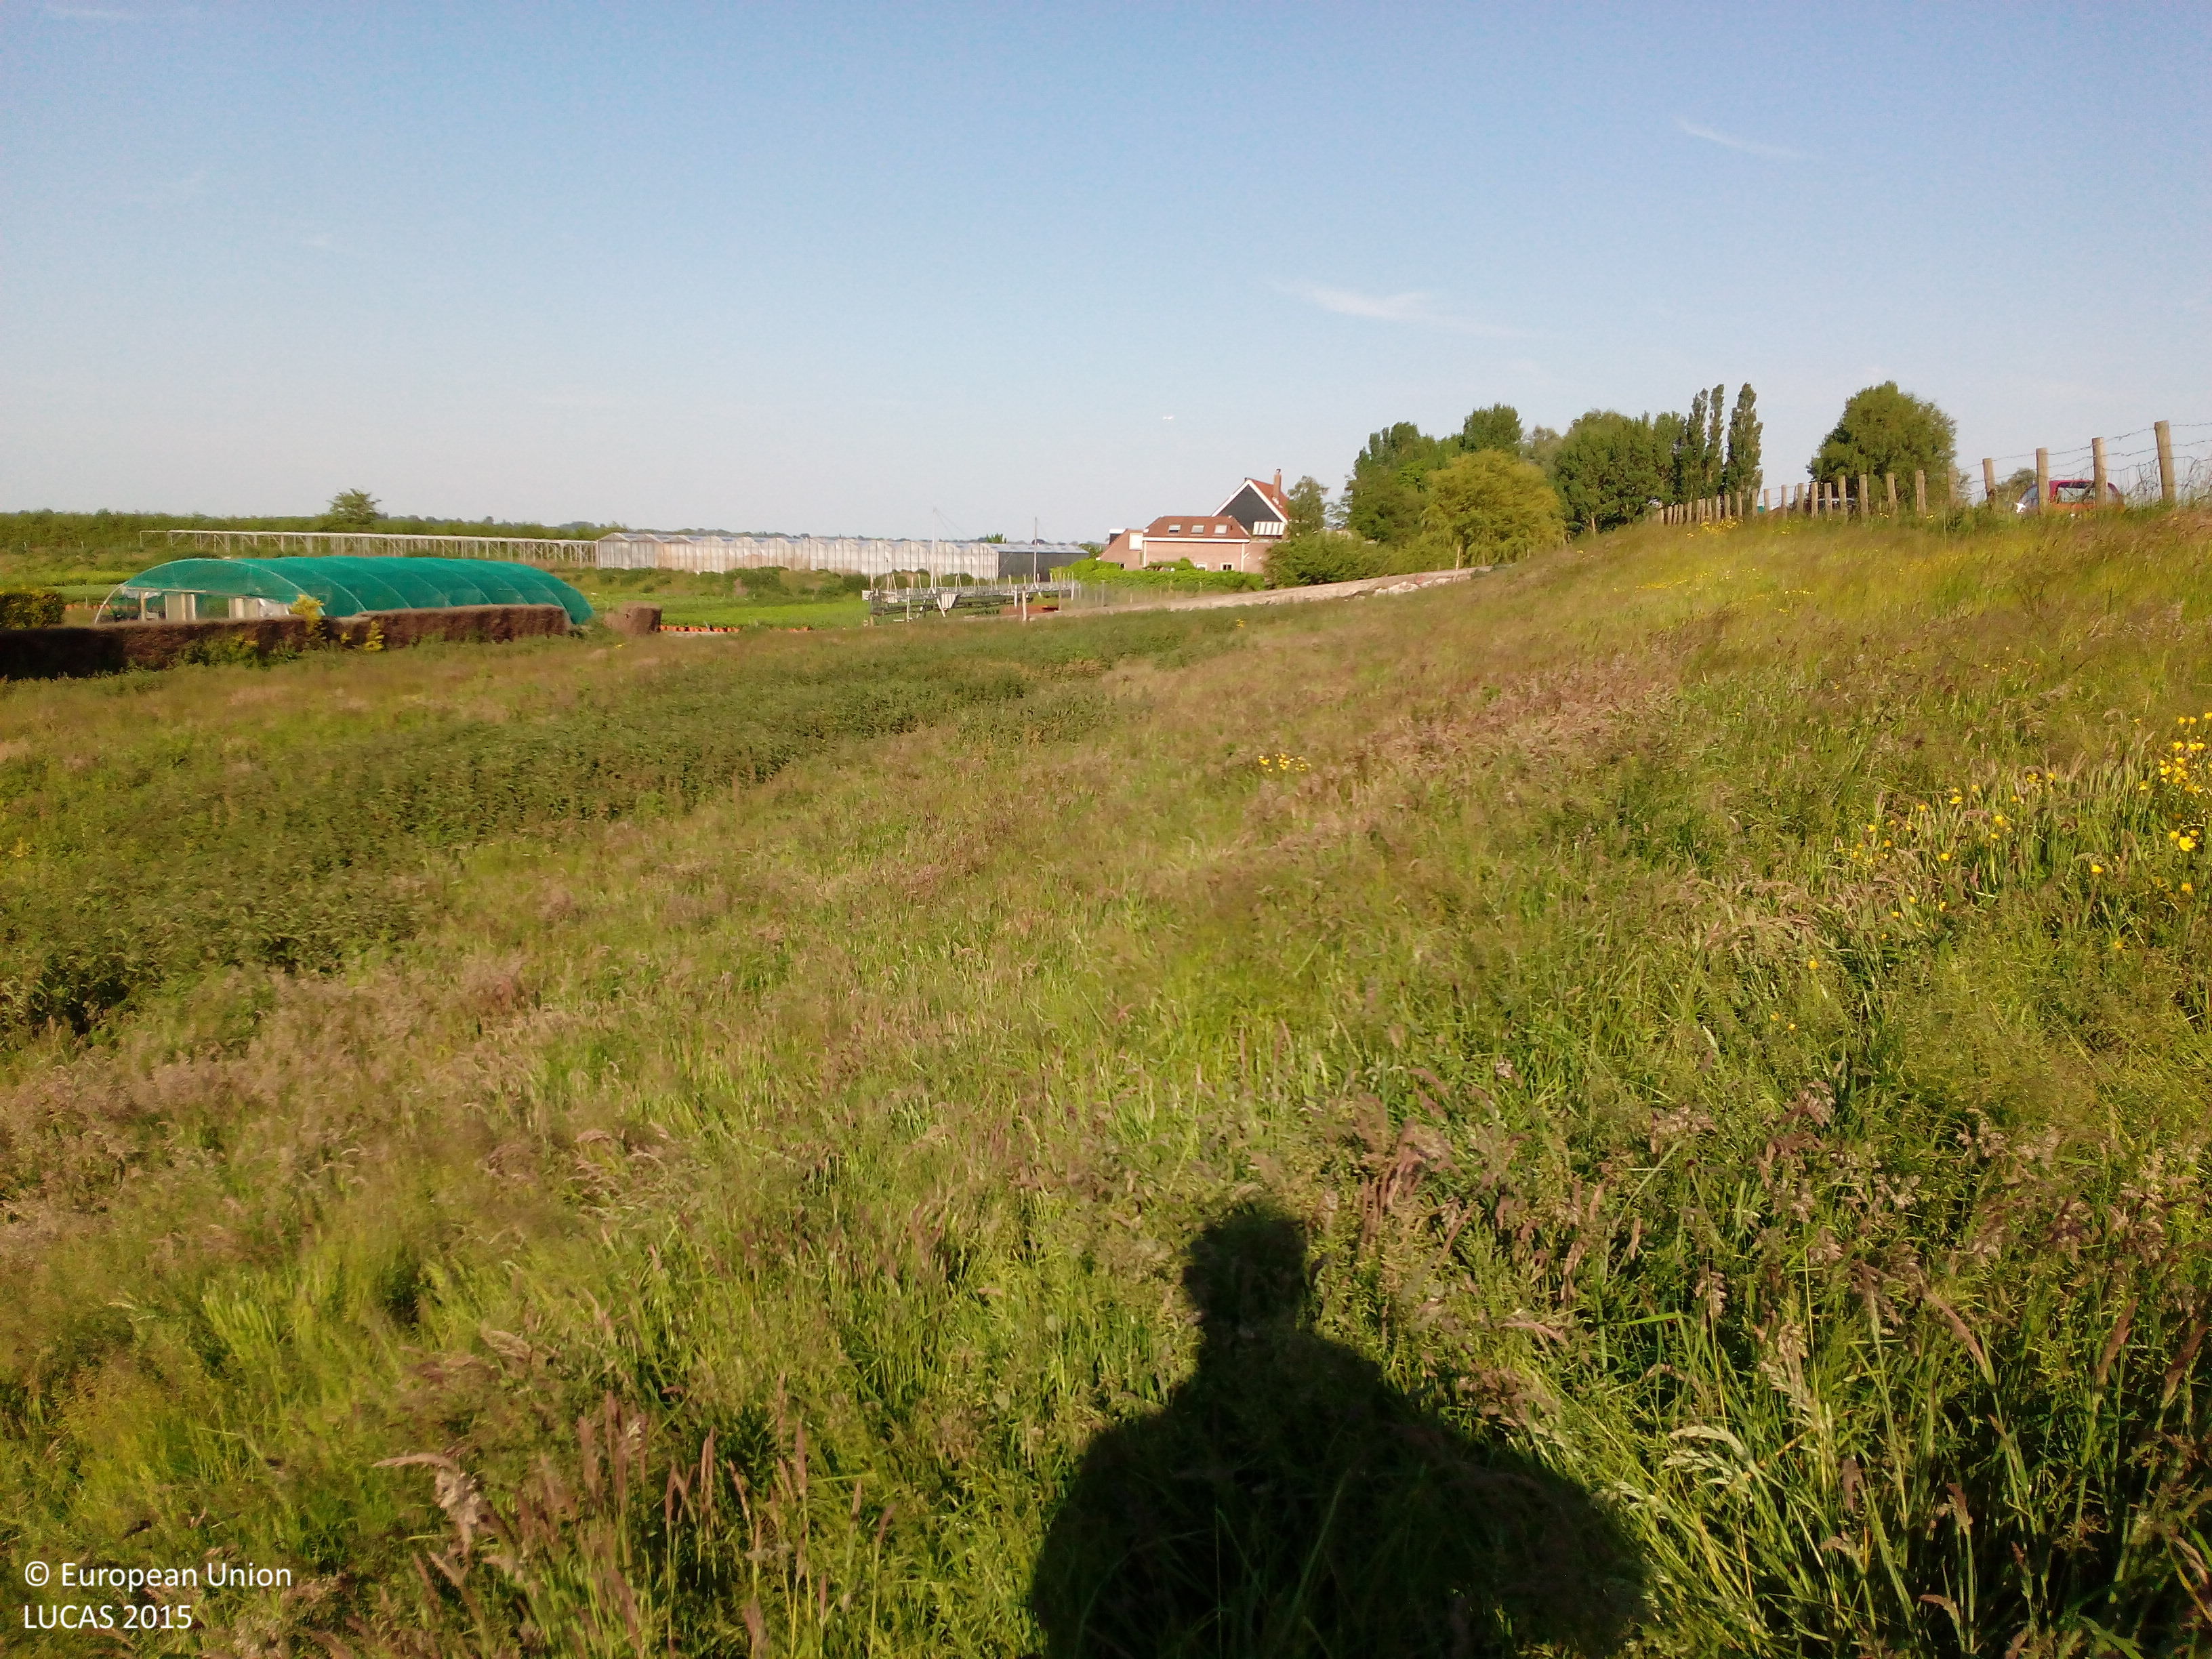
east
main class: Grassland
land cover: Grassland without tree/shrub cover
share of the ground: > 75 %
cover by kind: herbaceous plants 100 %
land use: Abandoned areas
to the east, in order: Grassland without tree/shrub cover; Artificial constructions in urban areas; Inland fresh running water; Grassland without tree/shrub cover
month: June
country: NL
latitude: 52.2223
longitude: 4.6827
